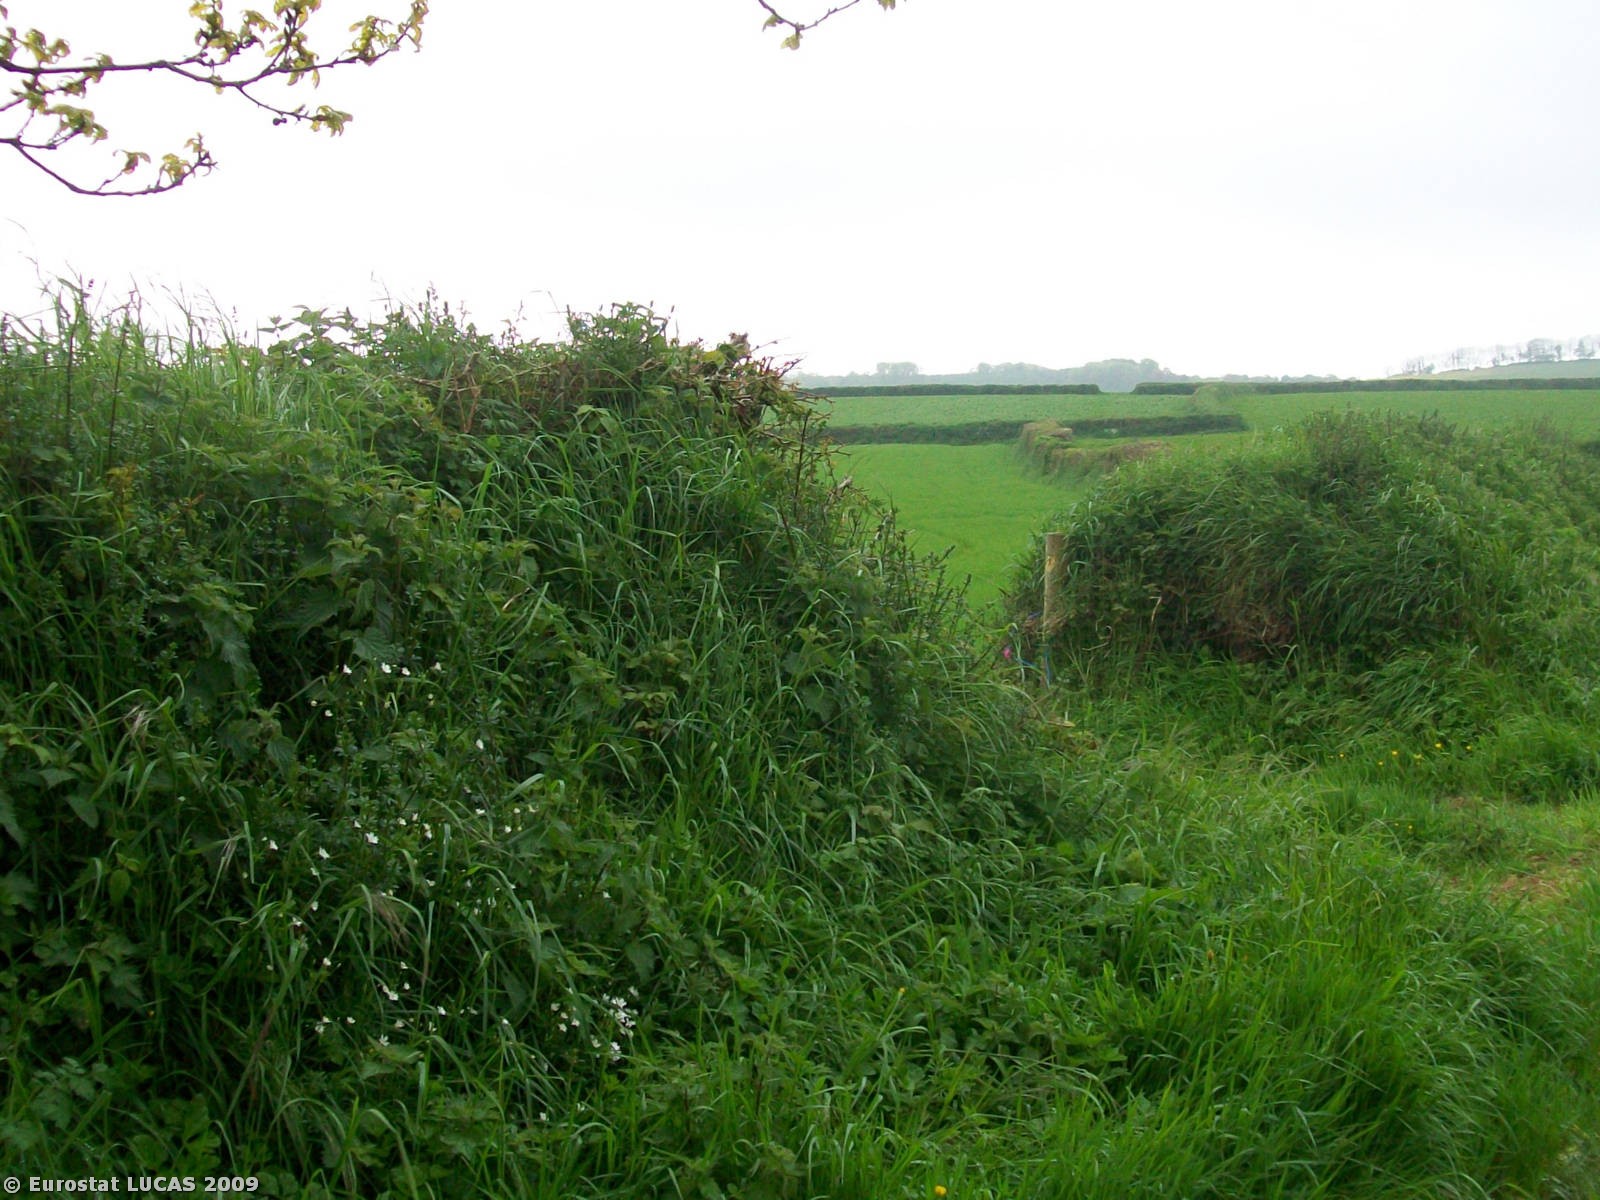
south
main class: Cropland
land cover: Common wheat
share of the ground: 50 - 75 %
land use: Agriculture (excluding fallow land and kitchen gardens)
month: May
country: GB
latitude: 50.4765
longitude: -4.3473
